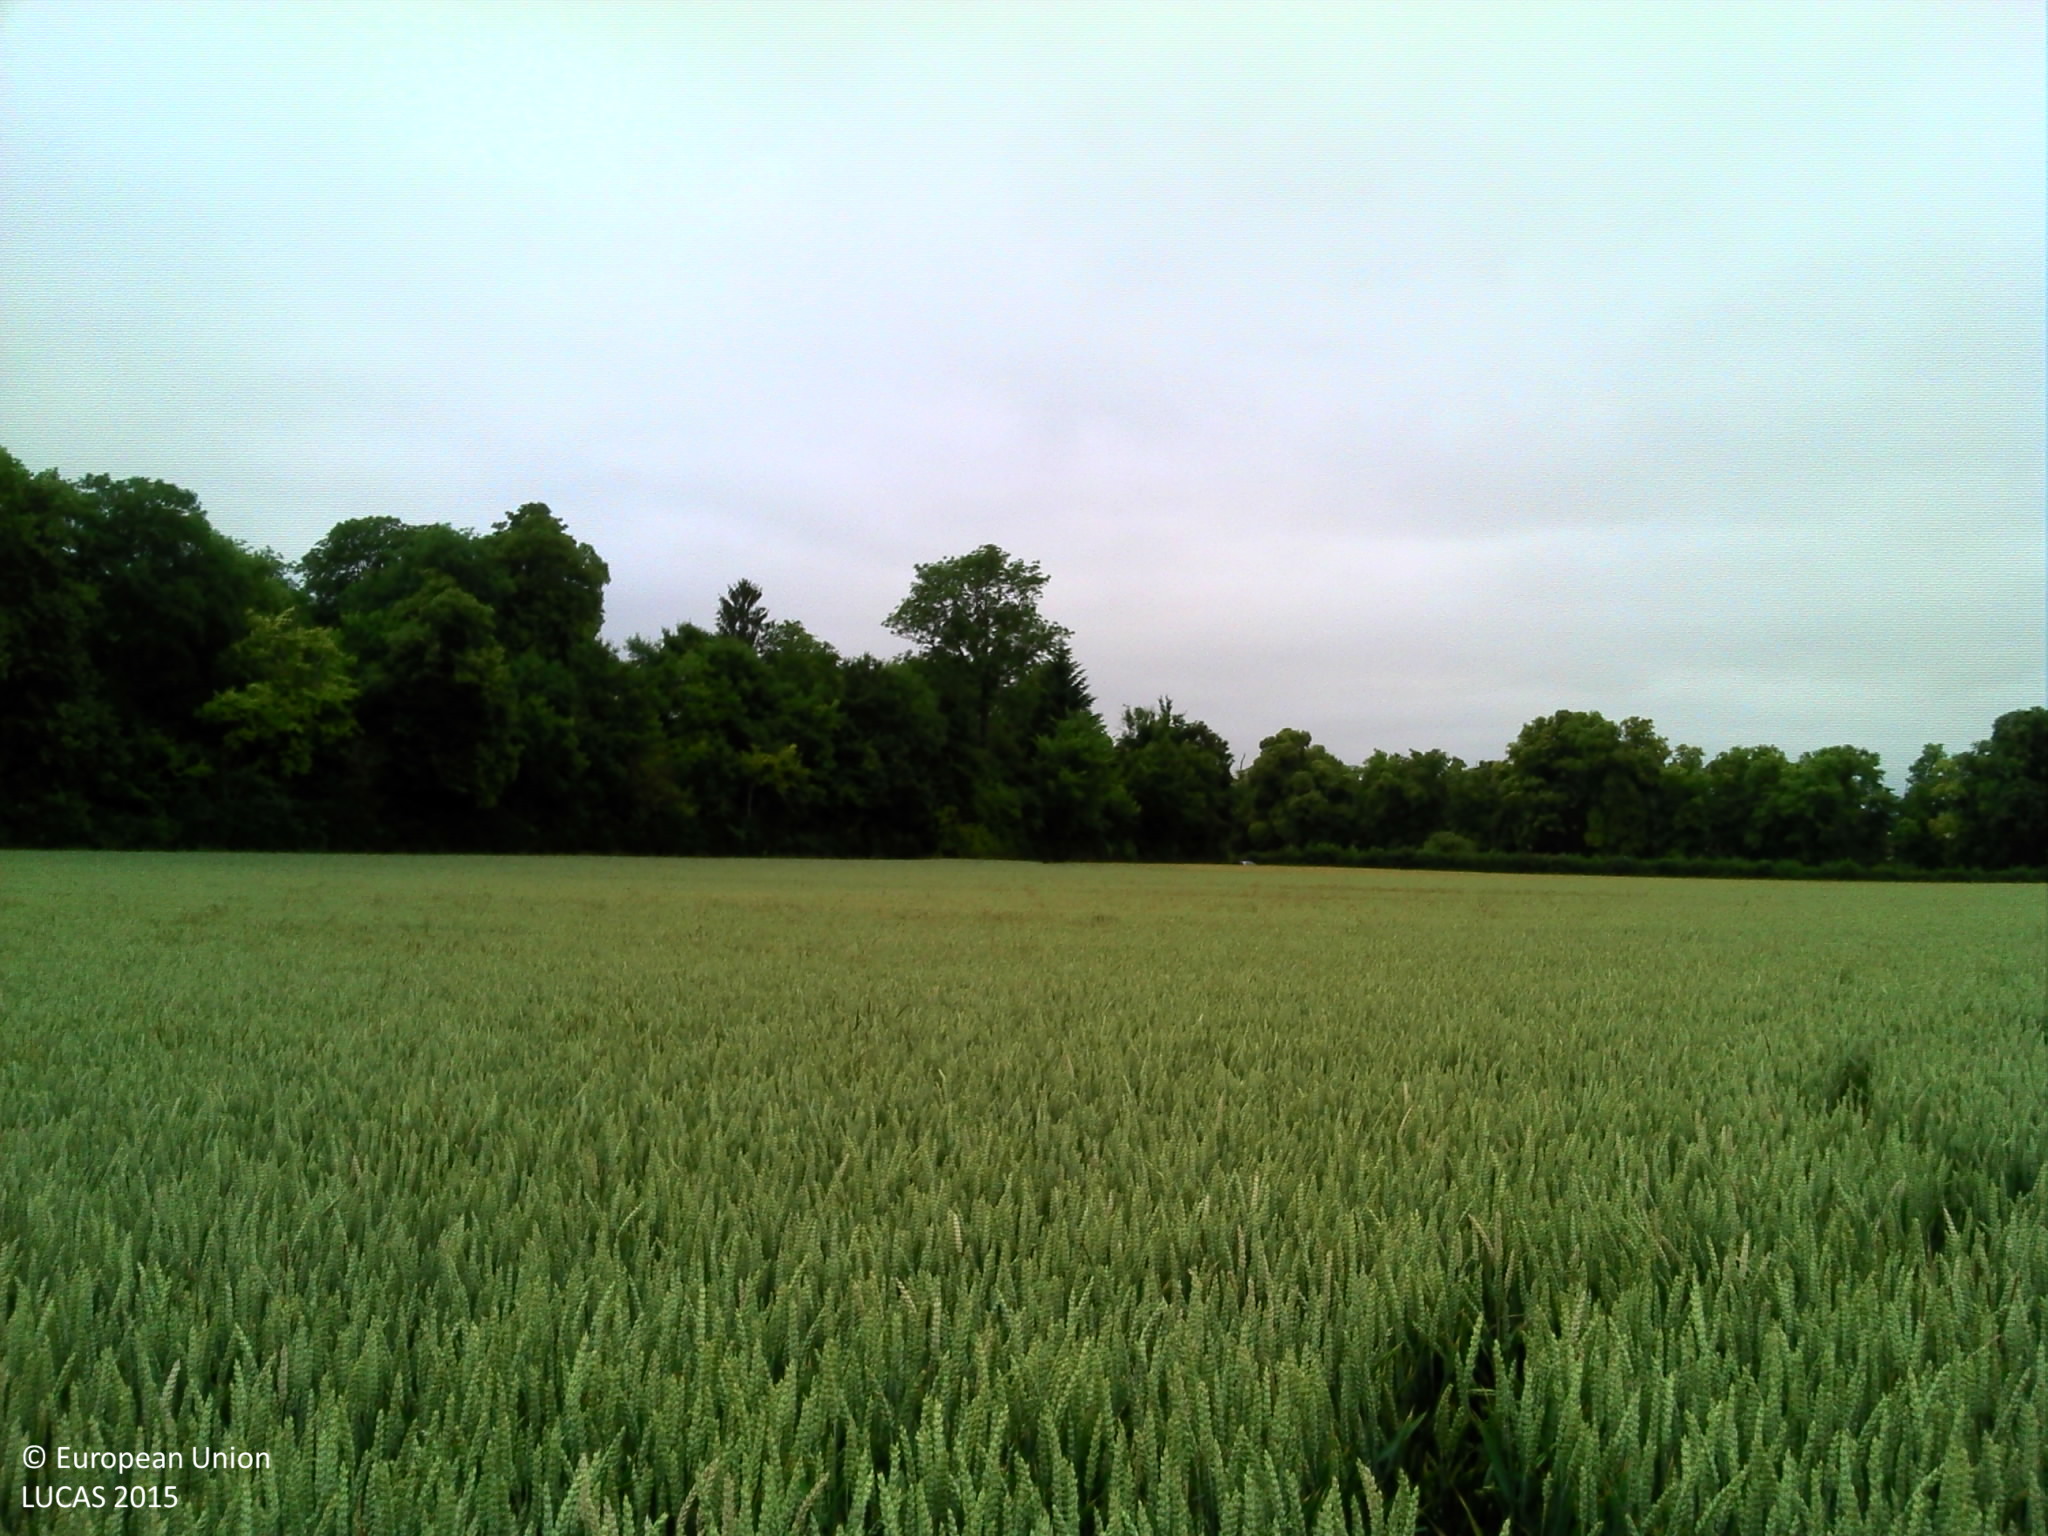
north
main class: Cropland
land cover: Common wheat
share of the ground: > 75 %
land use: Agriculture (excluding fallow land and kitchen gardens)
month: June
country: FR
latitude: 49.6169
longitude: 2.3050
